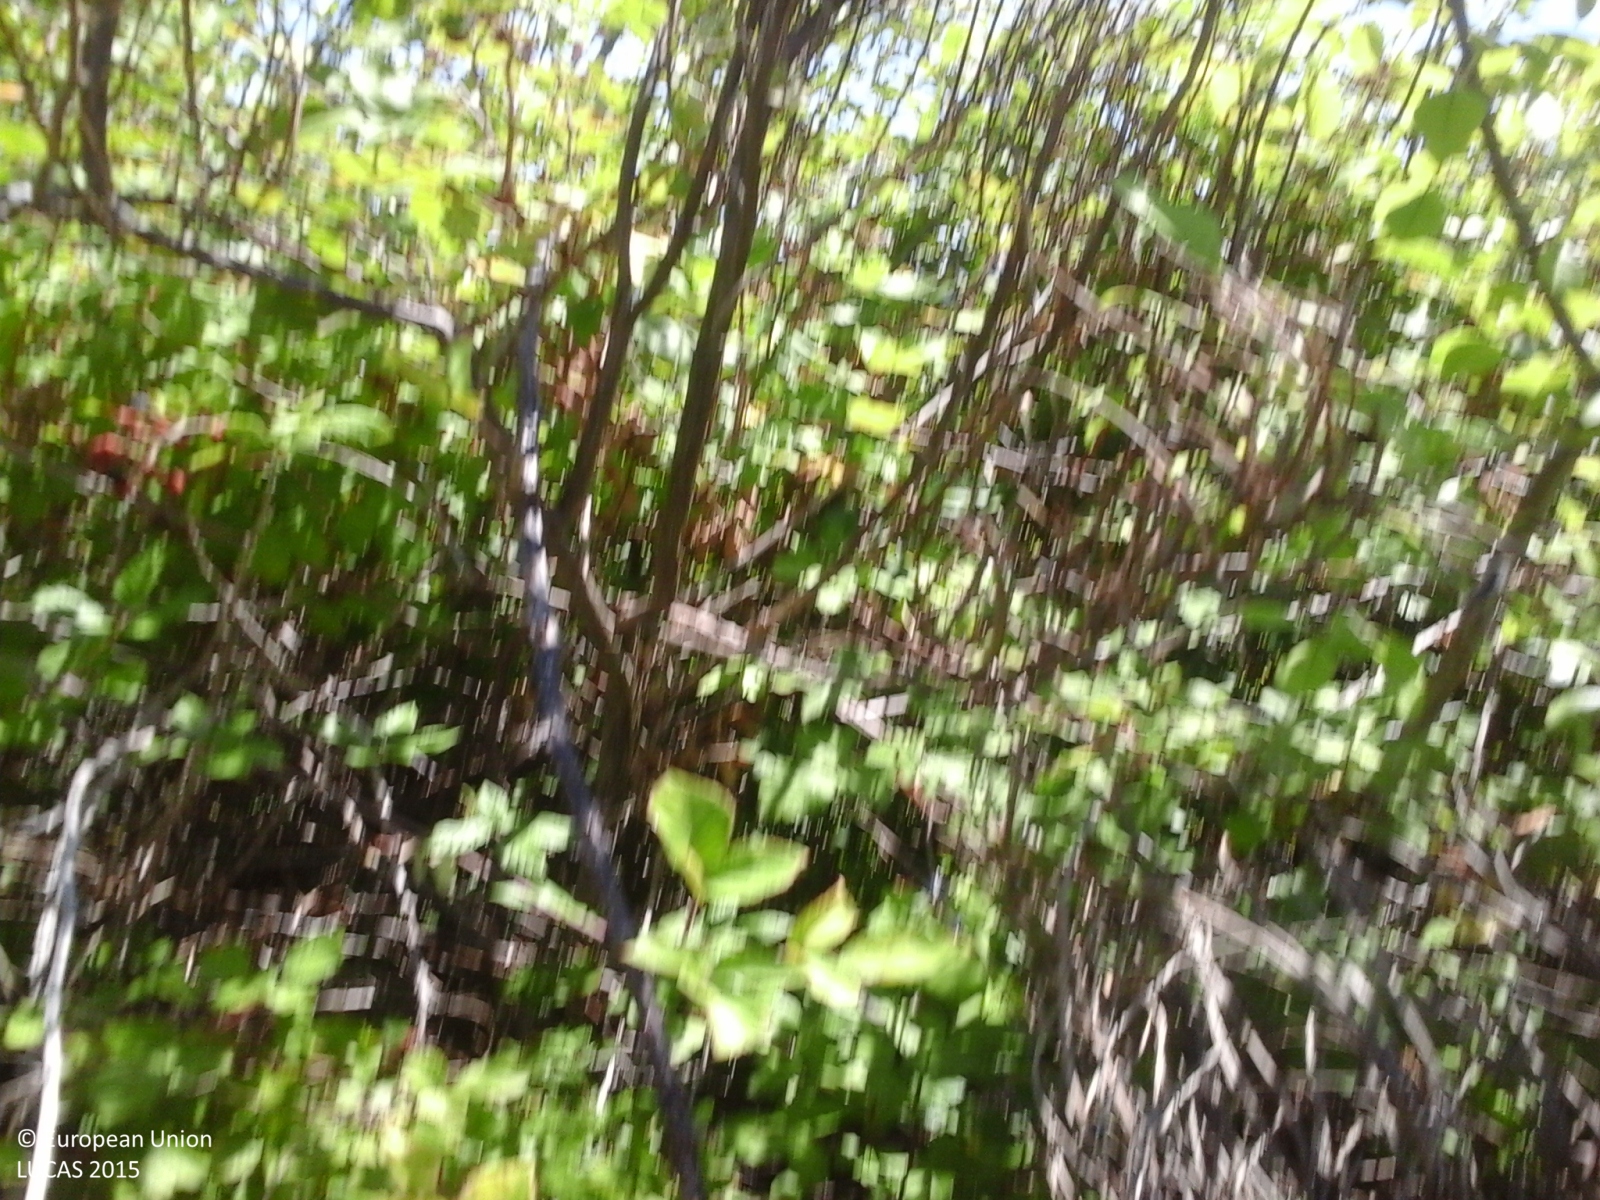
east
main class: Shrubland
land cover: Shrubland with sparse tree cover
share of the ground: > 75 %
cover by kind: shrubs 70 %, herbaceous plants 25 %, broadleaved forest trees 5 %
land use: Semi-natural and natural areas not in use
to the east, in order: Shrubland with sparse tree cover; Fences; Grass margins; Paved roads, cycling and walking lanes; Grass margins; Paved roads, cycling and walking lanes; Fences; Grassland with sparse tree/shrub cover; Olive groves; Broadleaved woodland; Grassland without tree/shrub cover
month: August
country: IT
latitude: 42.6776
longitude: 11.5934
